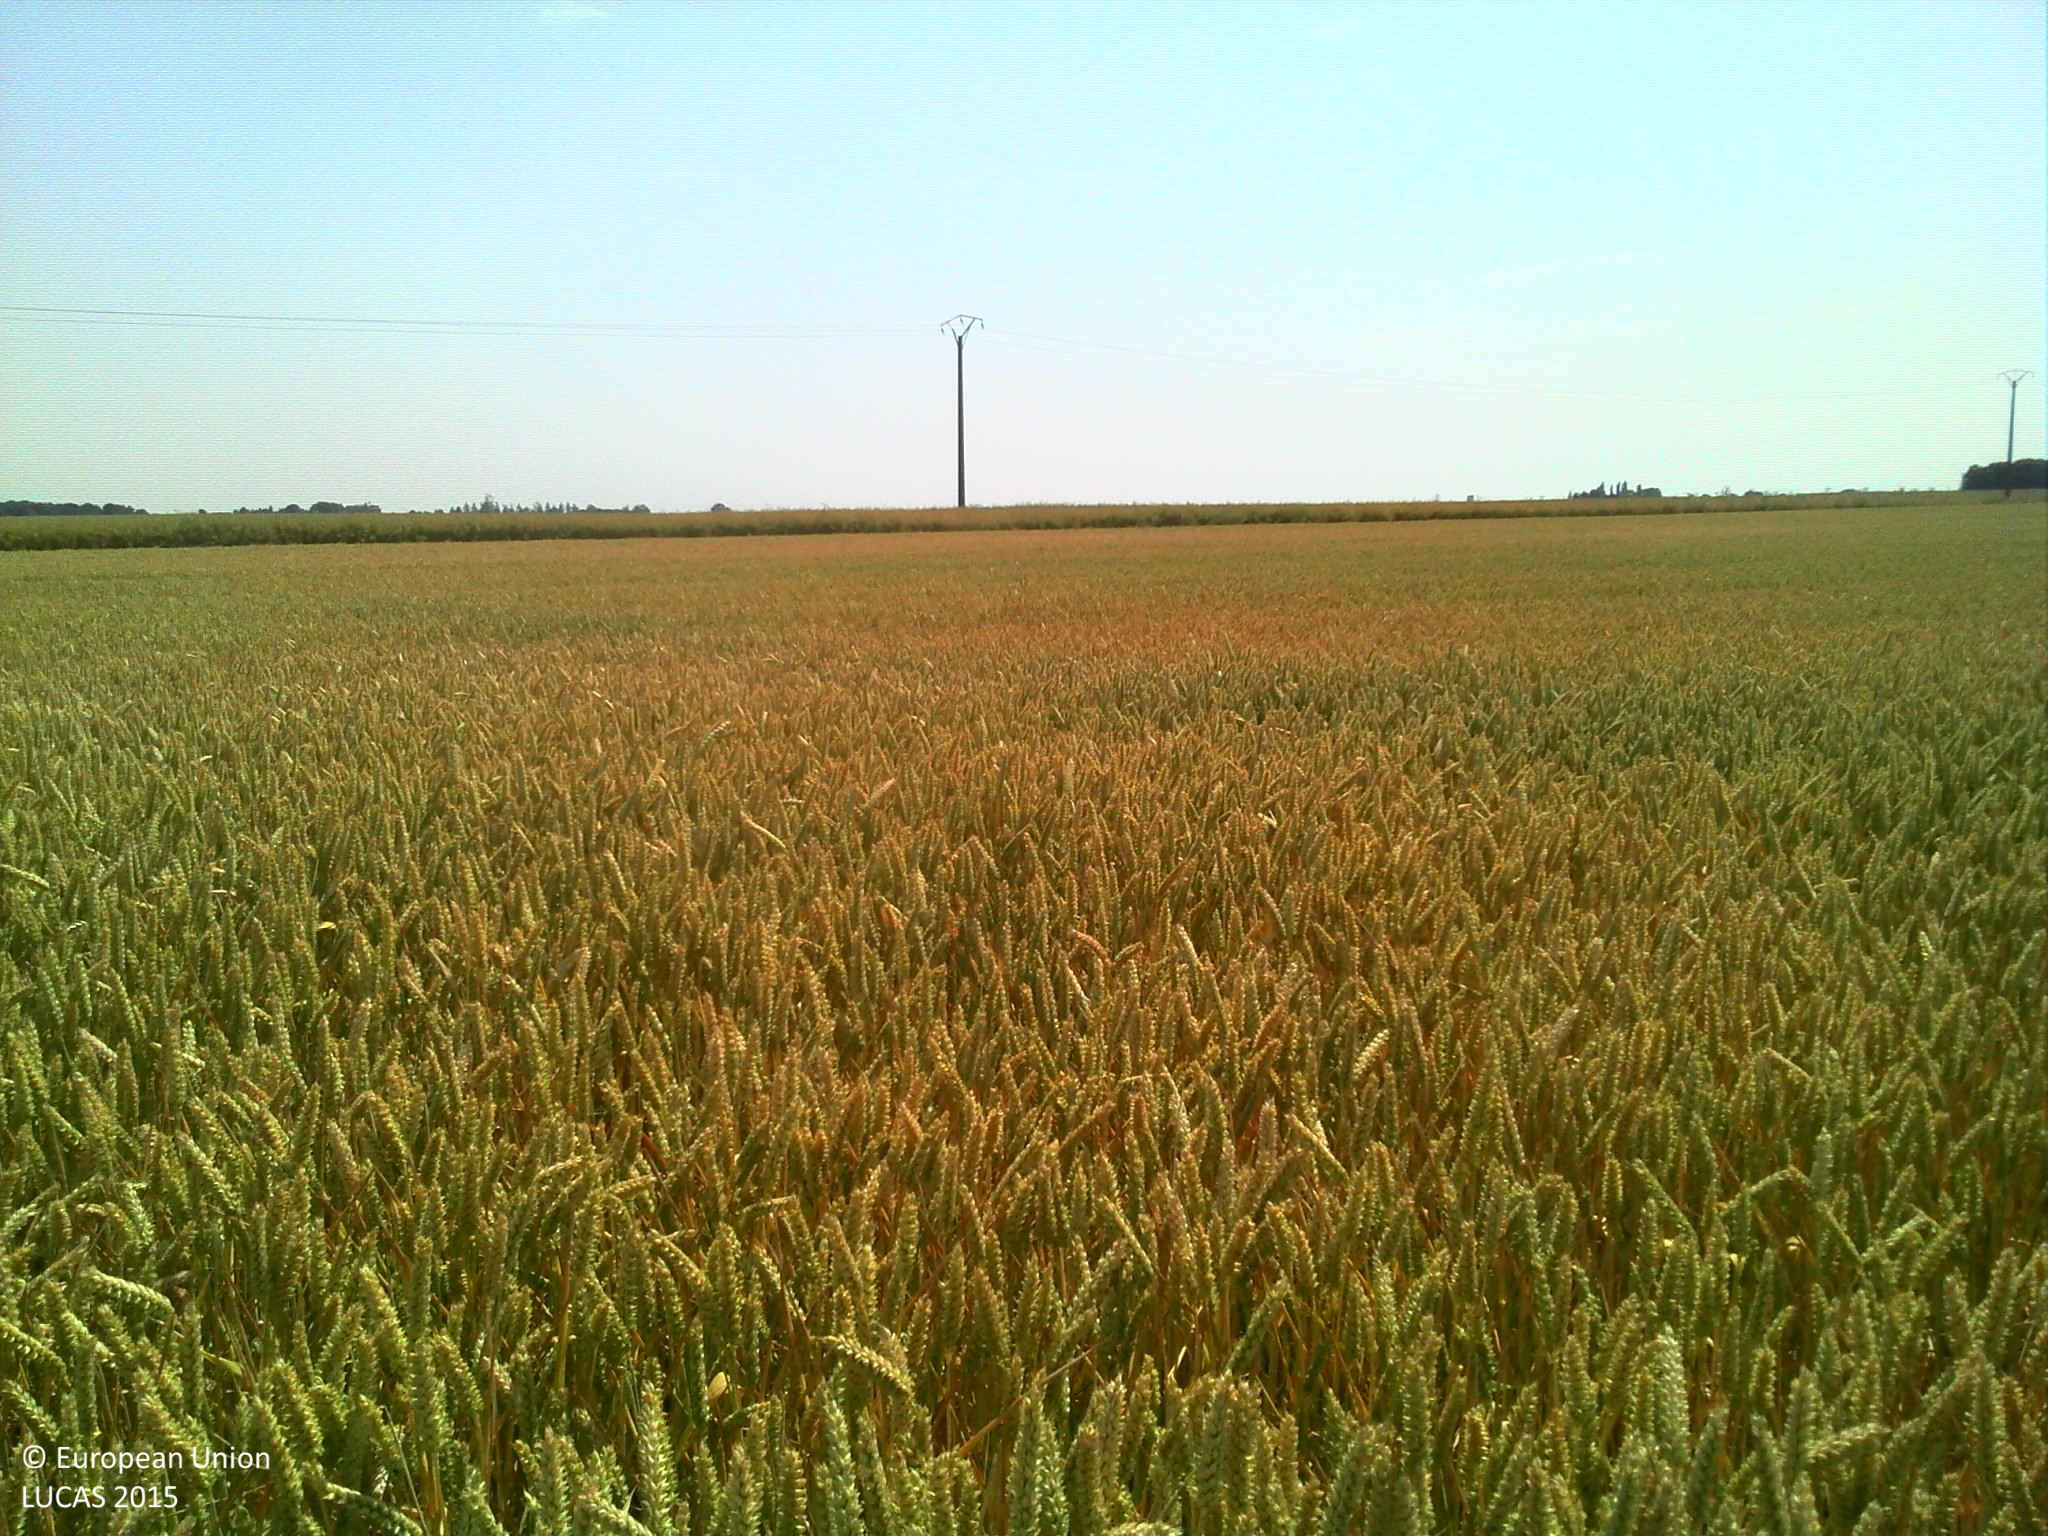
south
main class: Cropland
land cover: Common wheat
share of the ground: > 75 %
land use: Agriculture (excluding fallow land and kitchen gardens)
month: July
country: FR
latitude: 48.9454
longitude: 1.2832
